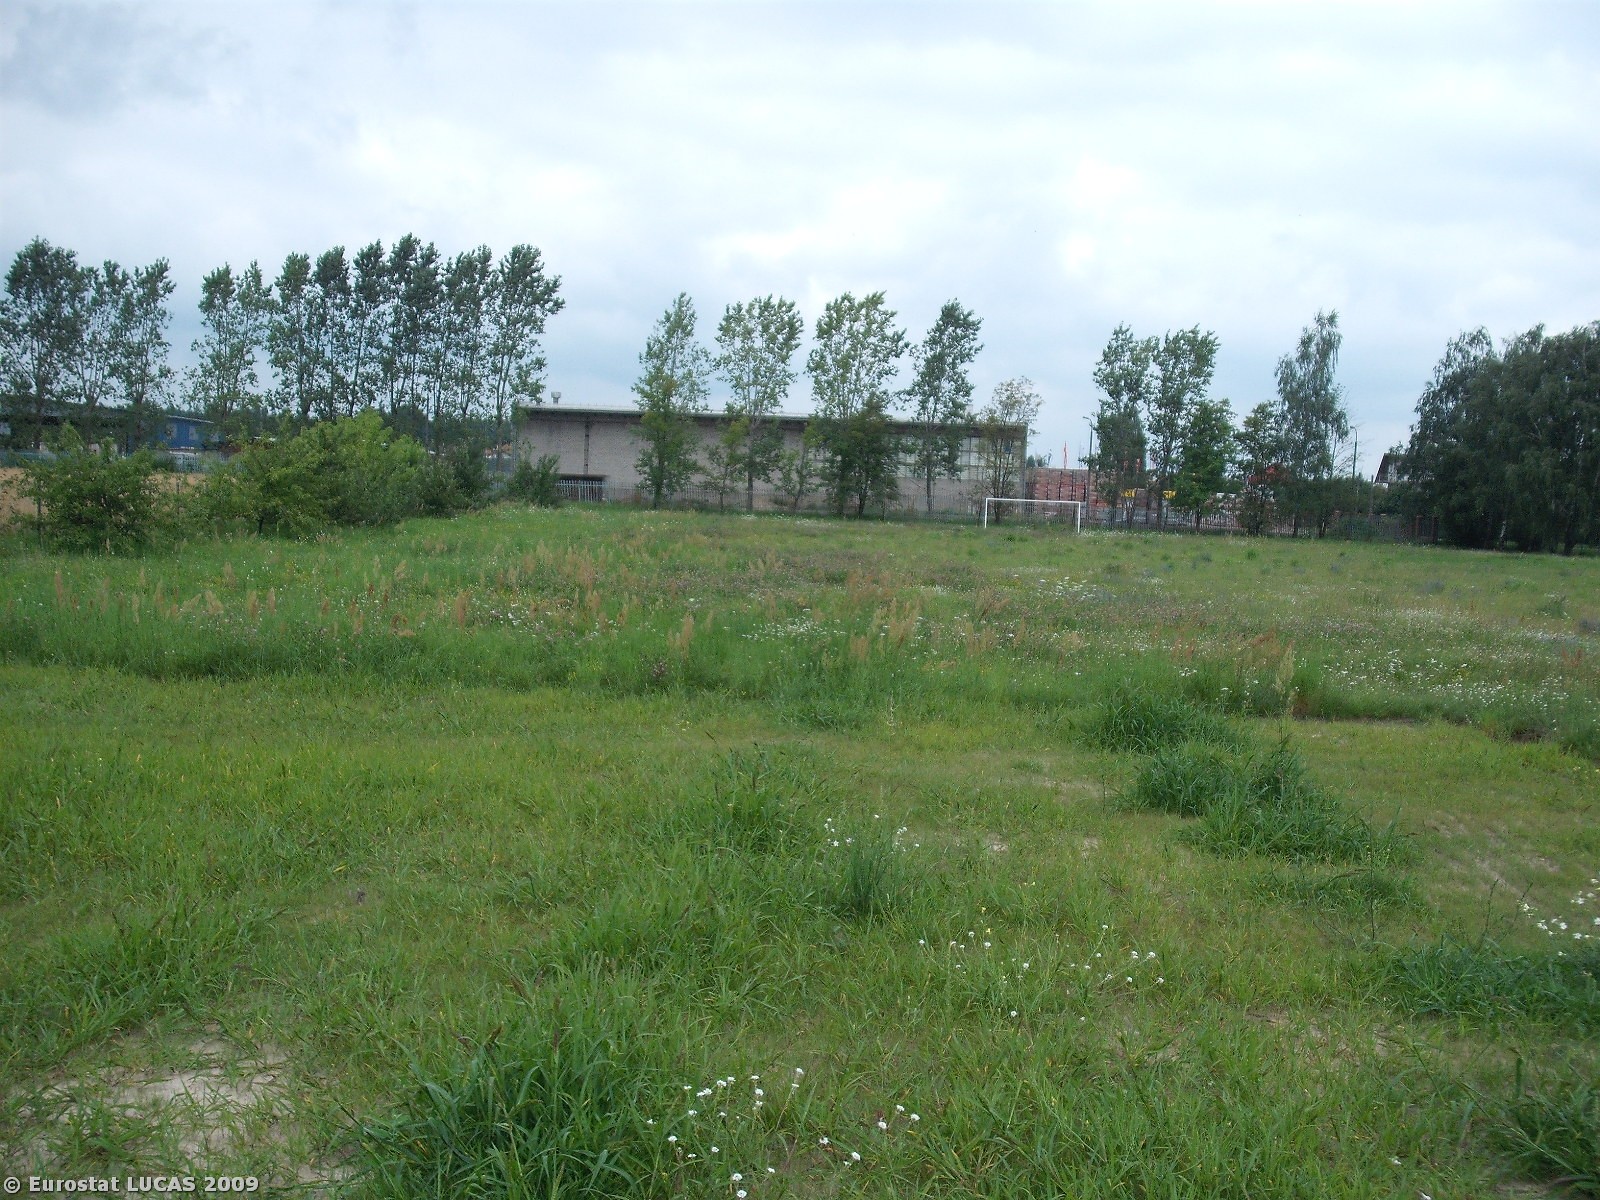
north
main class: Grassland
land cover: Grassland without tree/shrub cover
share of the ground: 25 - 50 %
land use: Community services
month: July
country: PL
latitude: 50.9577
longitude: 21.3674
